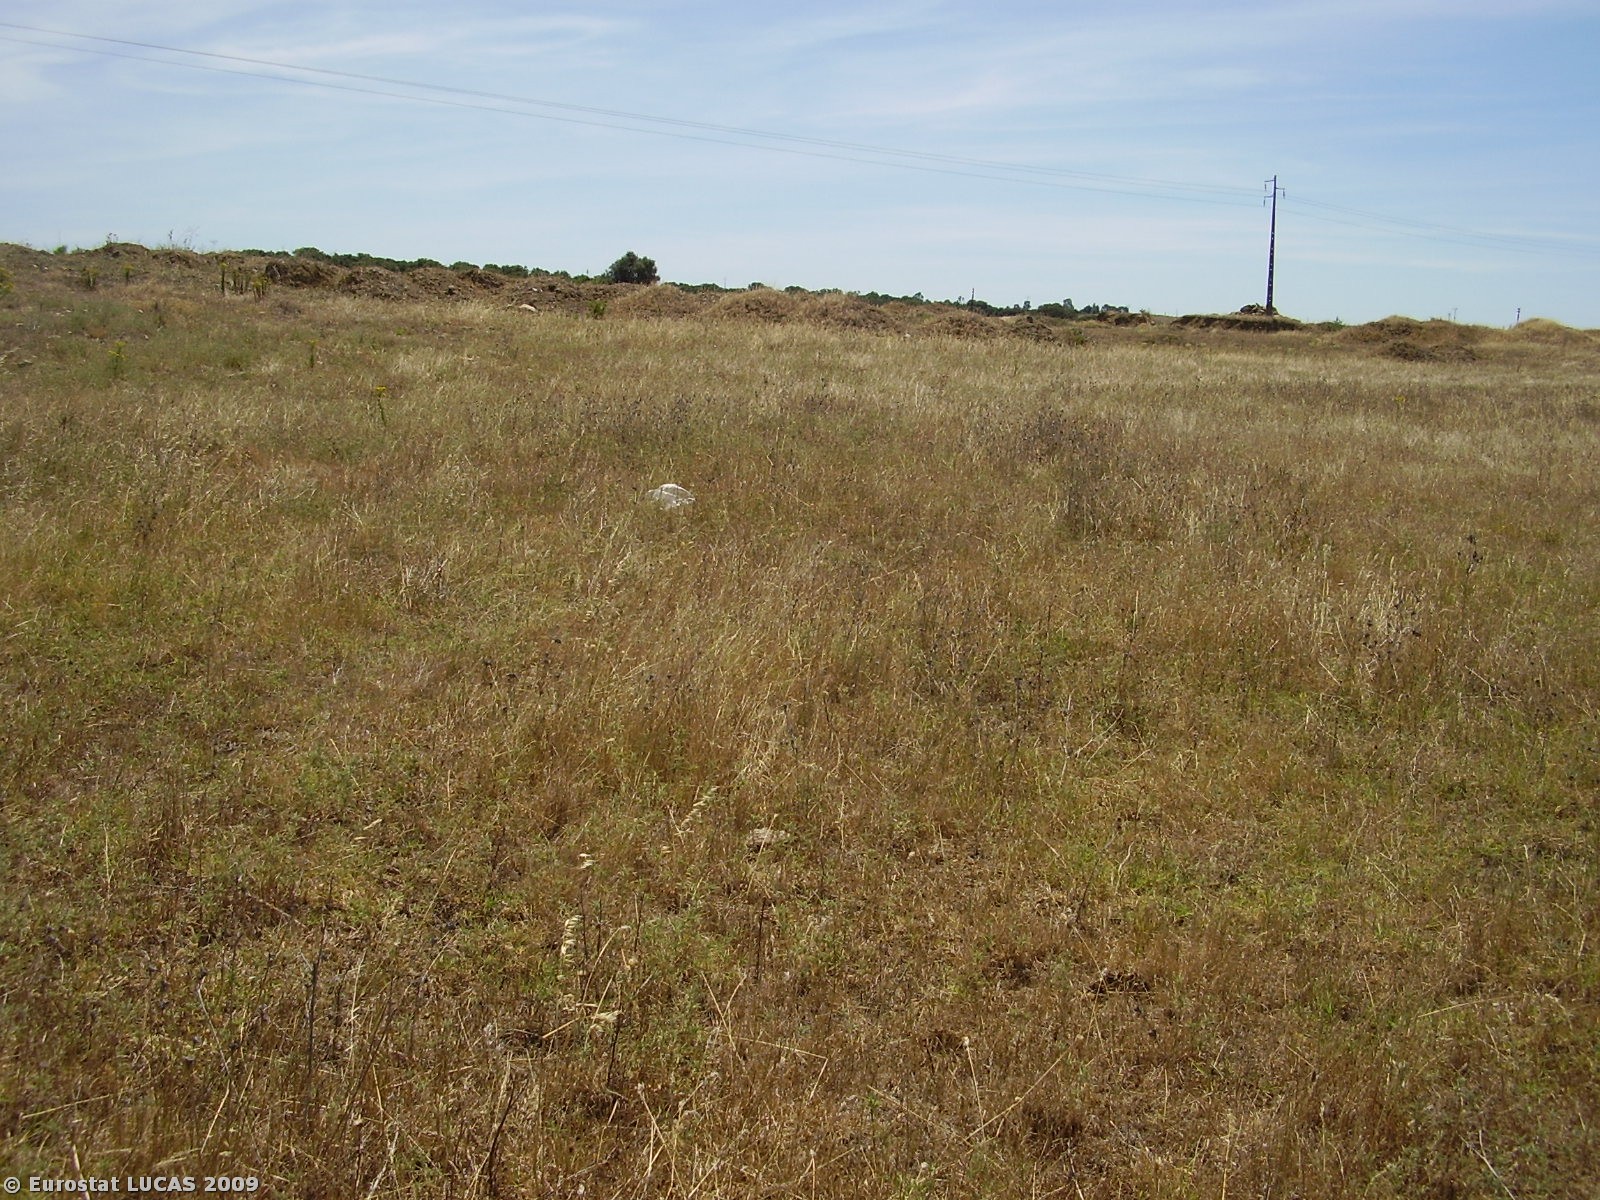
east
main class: Grassland
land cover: Grassland without tree/shrub cover
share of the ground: > 75 %
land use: Fallow land
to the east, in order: Grassland without tree/shrub cover; Electric lines; Grassland without tree/shrub cover; Fences; Spontaneously vegetated surfaces
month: July
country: PT
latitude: 38.5890
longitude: -7.8917
